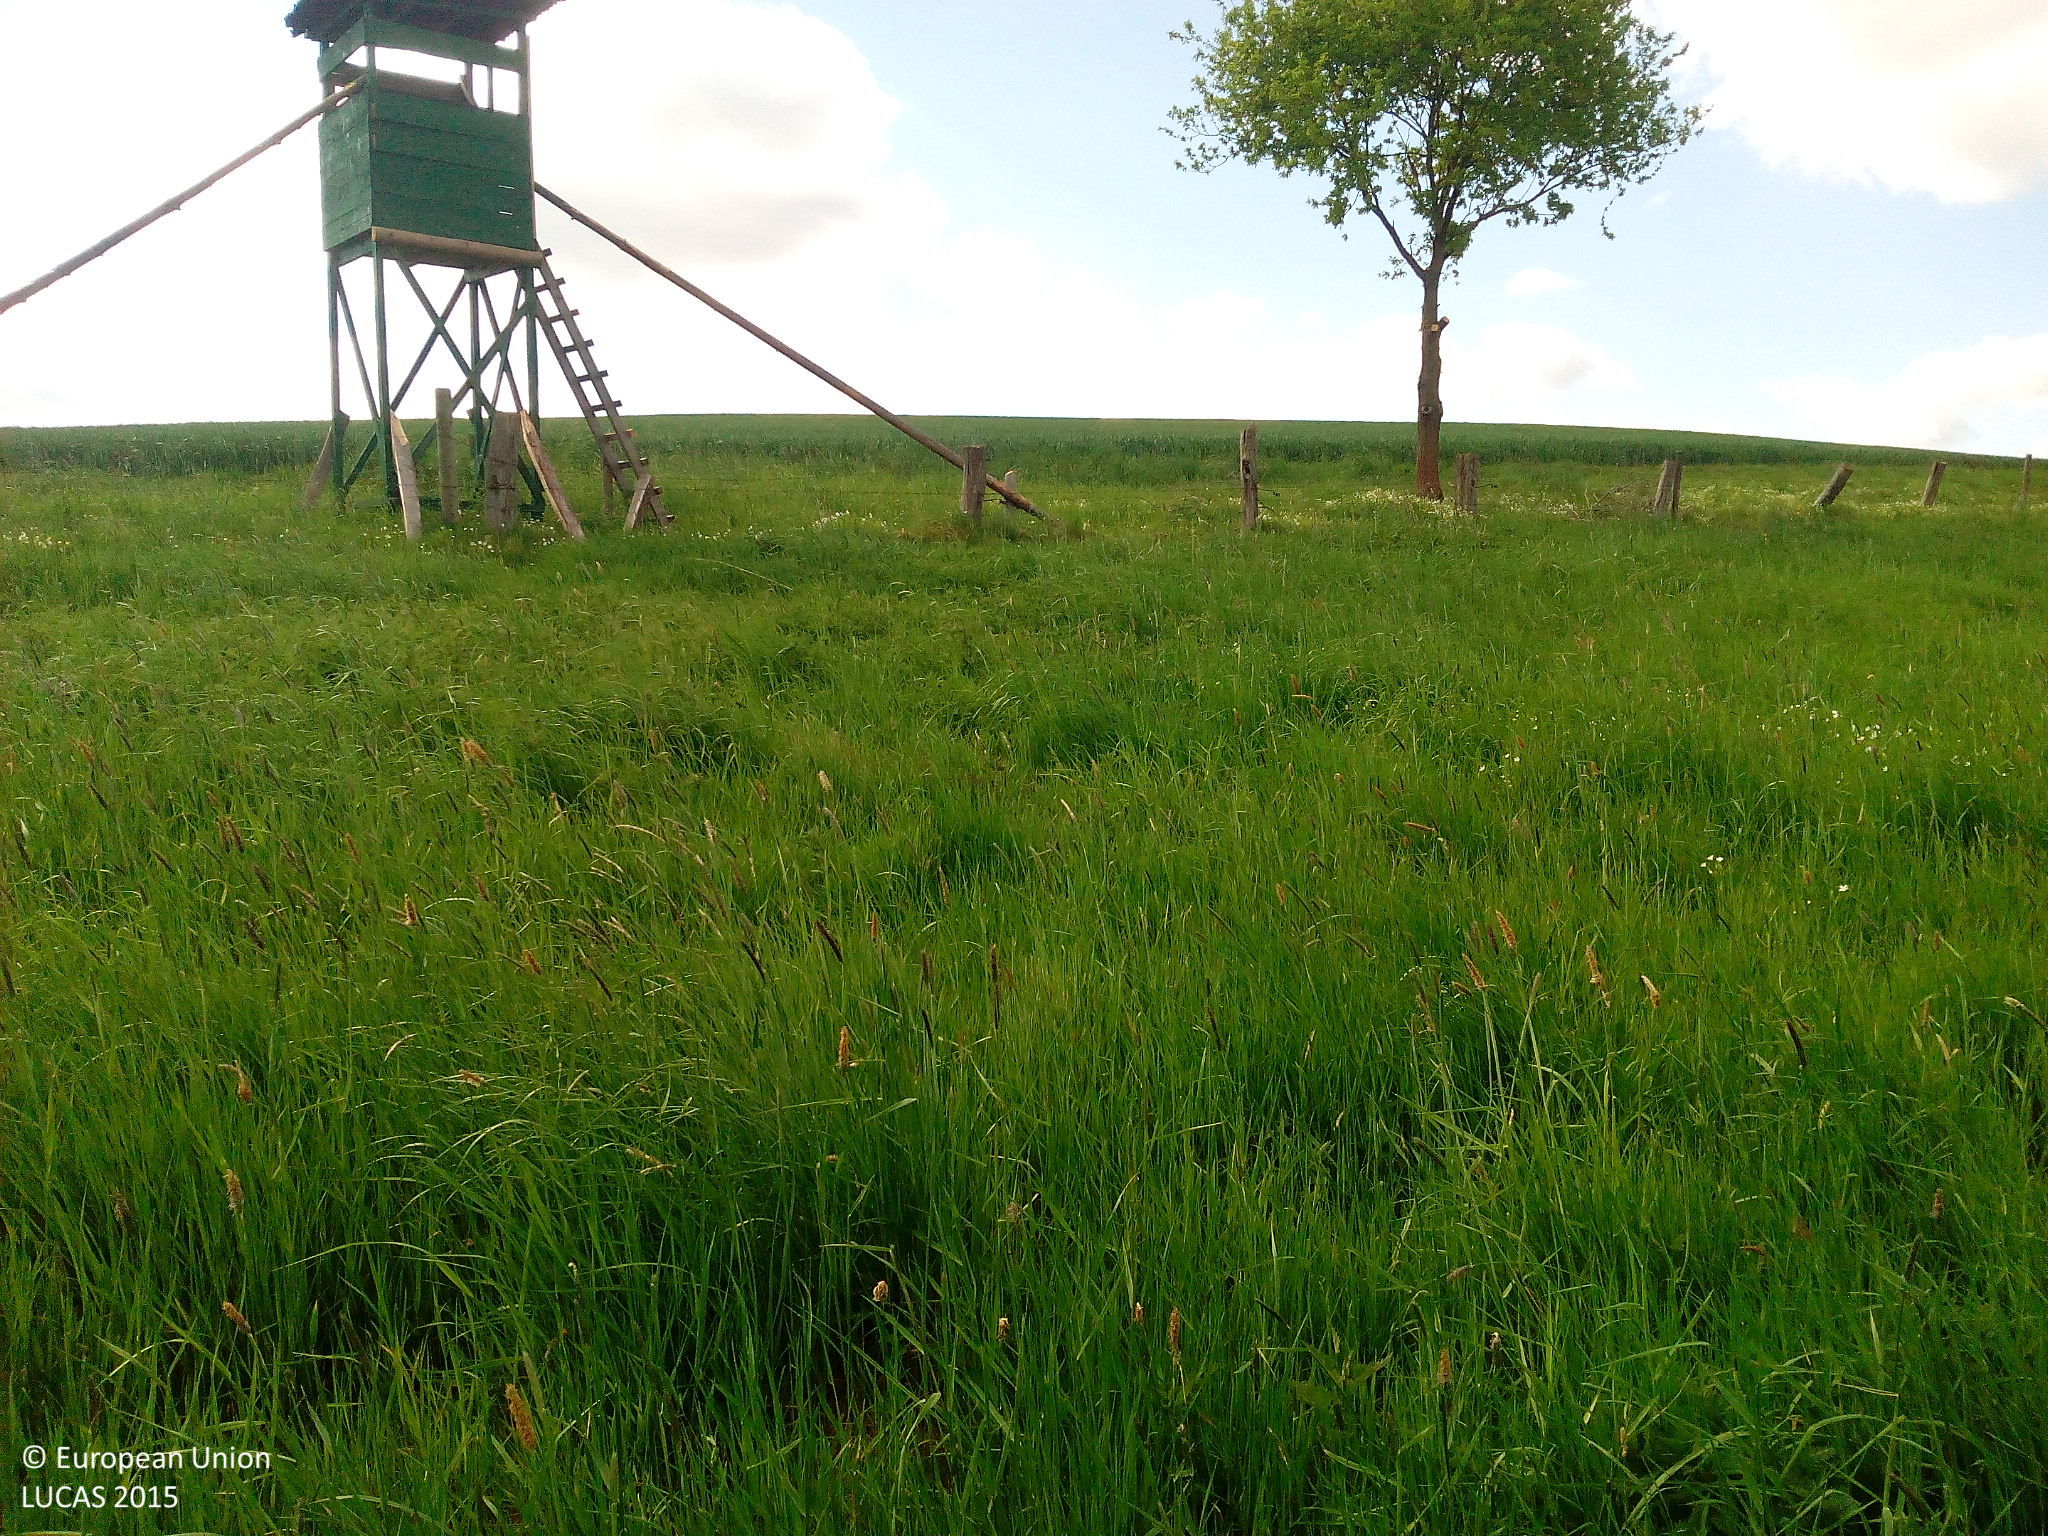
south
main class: Grassland
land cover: Grassland without tree/shrub cover
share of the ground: > 75 %
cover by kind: herbaceous plants 100 %
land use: Agriculture (excluding fallow land and kitchen gardens)
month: May
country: DE
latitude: 51.3344
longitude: 9.6413
